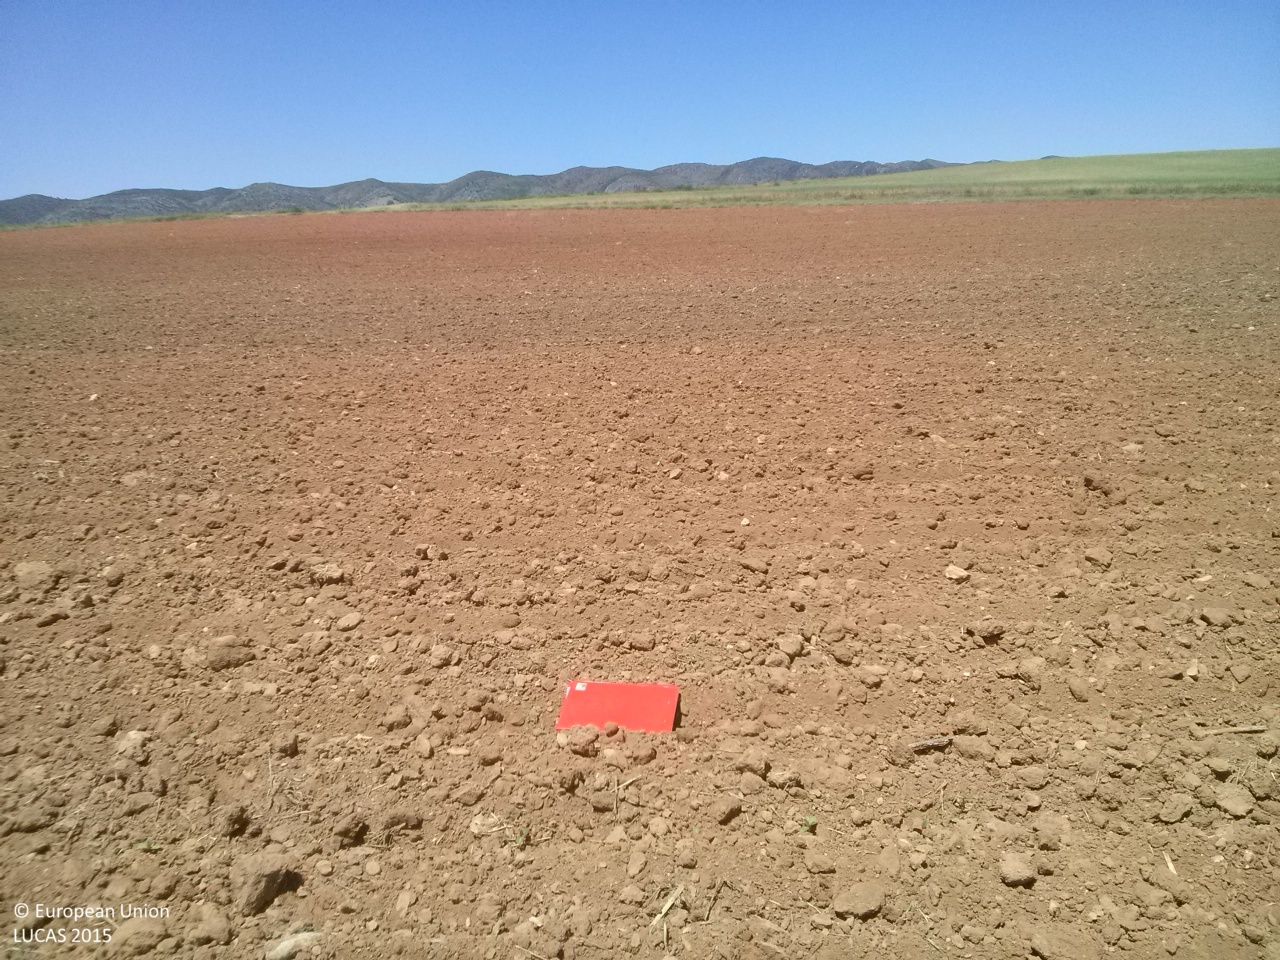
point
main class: Cropland
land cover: Sunflower
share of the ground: < 10 %
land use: Agriculture (excluding fallow land and kitchen gardens)
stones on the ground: < 10 %
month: May
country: ES
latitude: 40.2361
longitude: -2.7533
